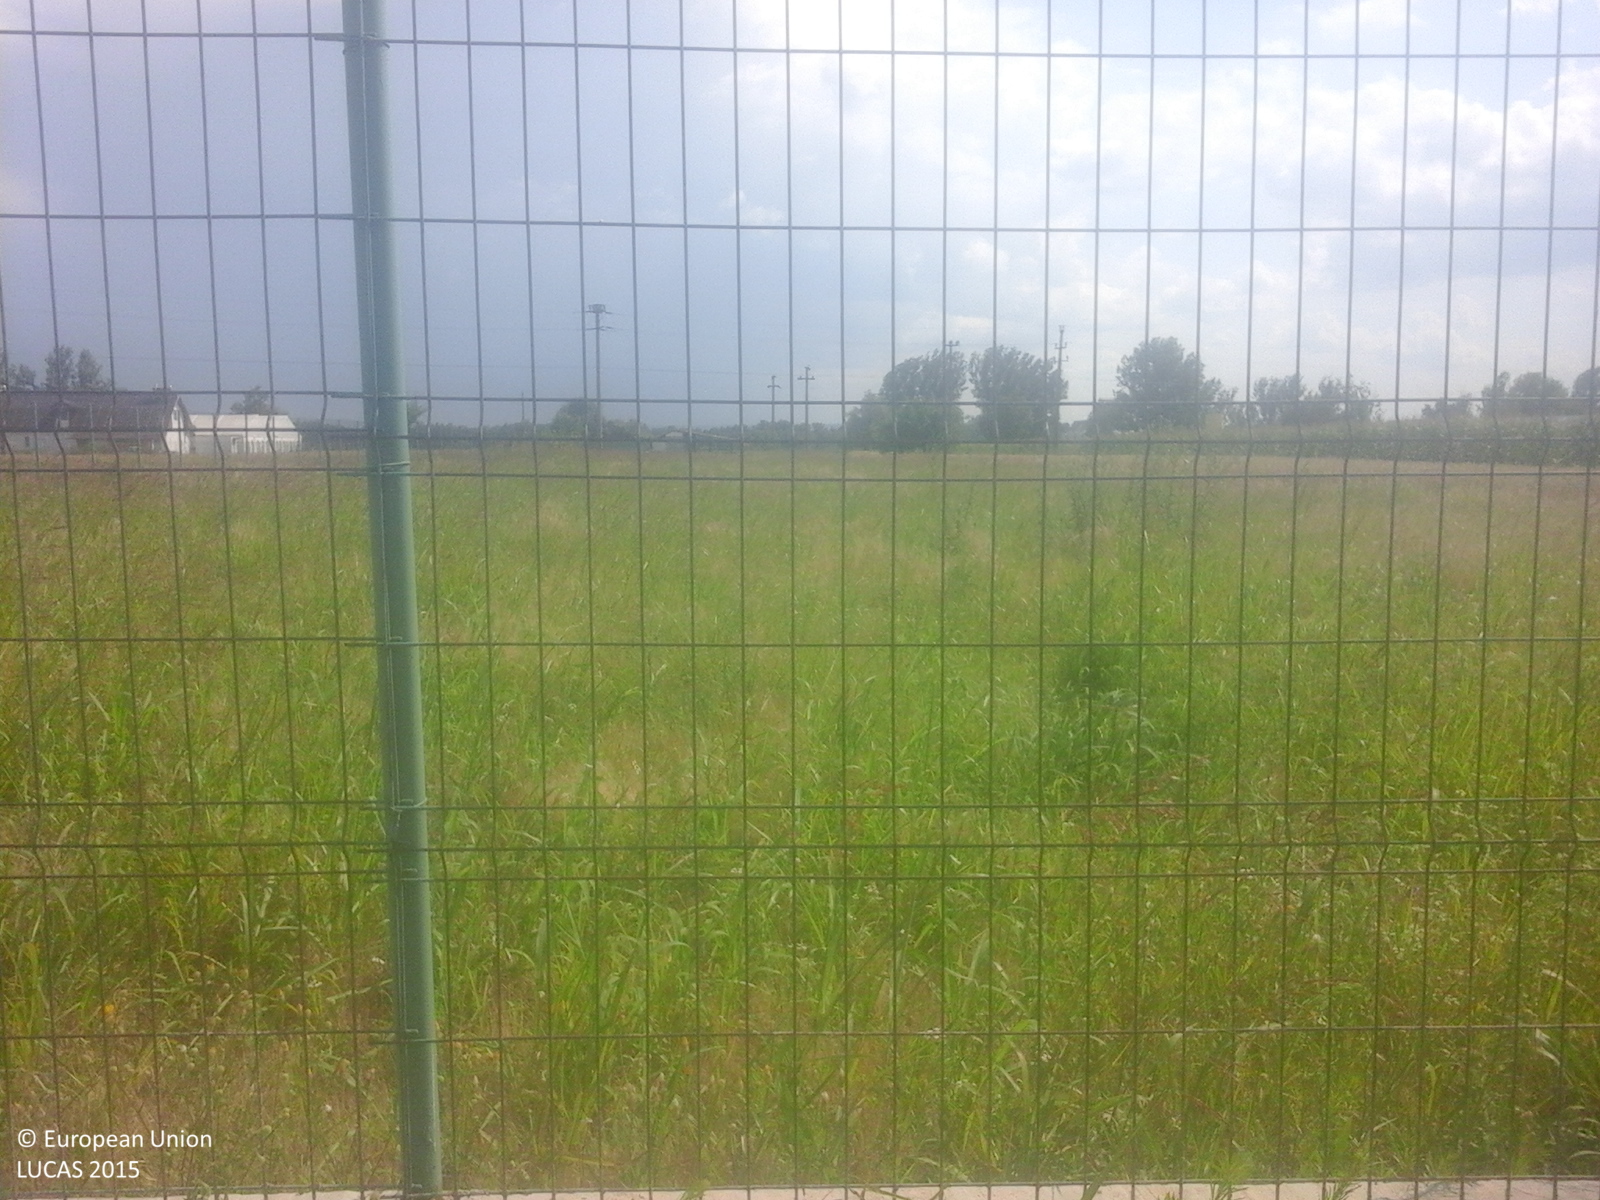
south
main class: Grassland
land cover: Grassland without tree/shrub cover
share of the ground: > 75 %
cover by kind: herbaceous plants 100 %
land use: Agriculture (excluding fallow land and kitchen gardens)
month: July
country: RO
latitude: 43.7777
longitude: 24.5397
